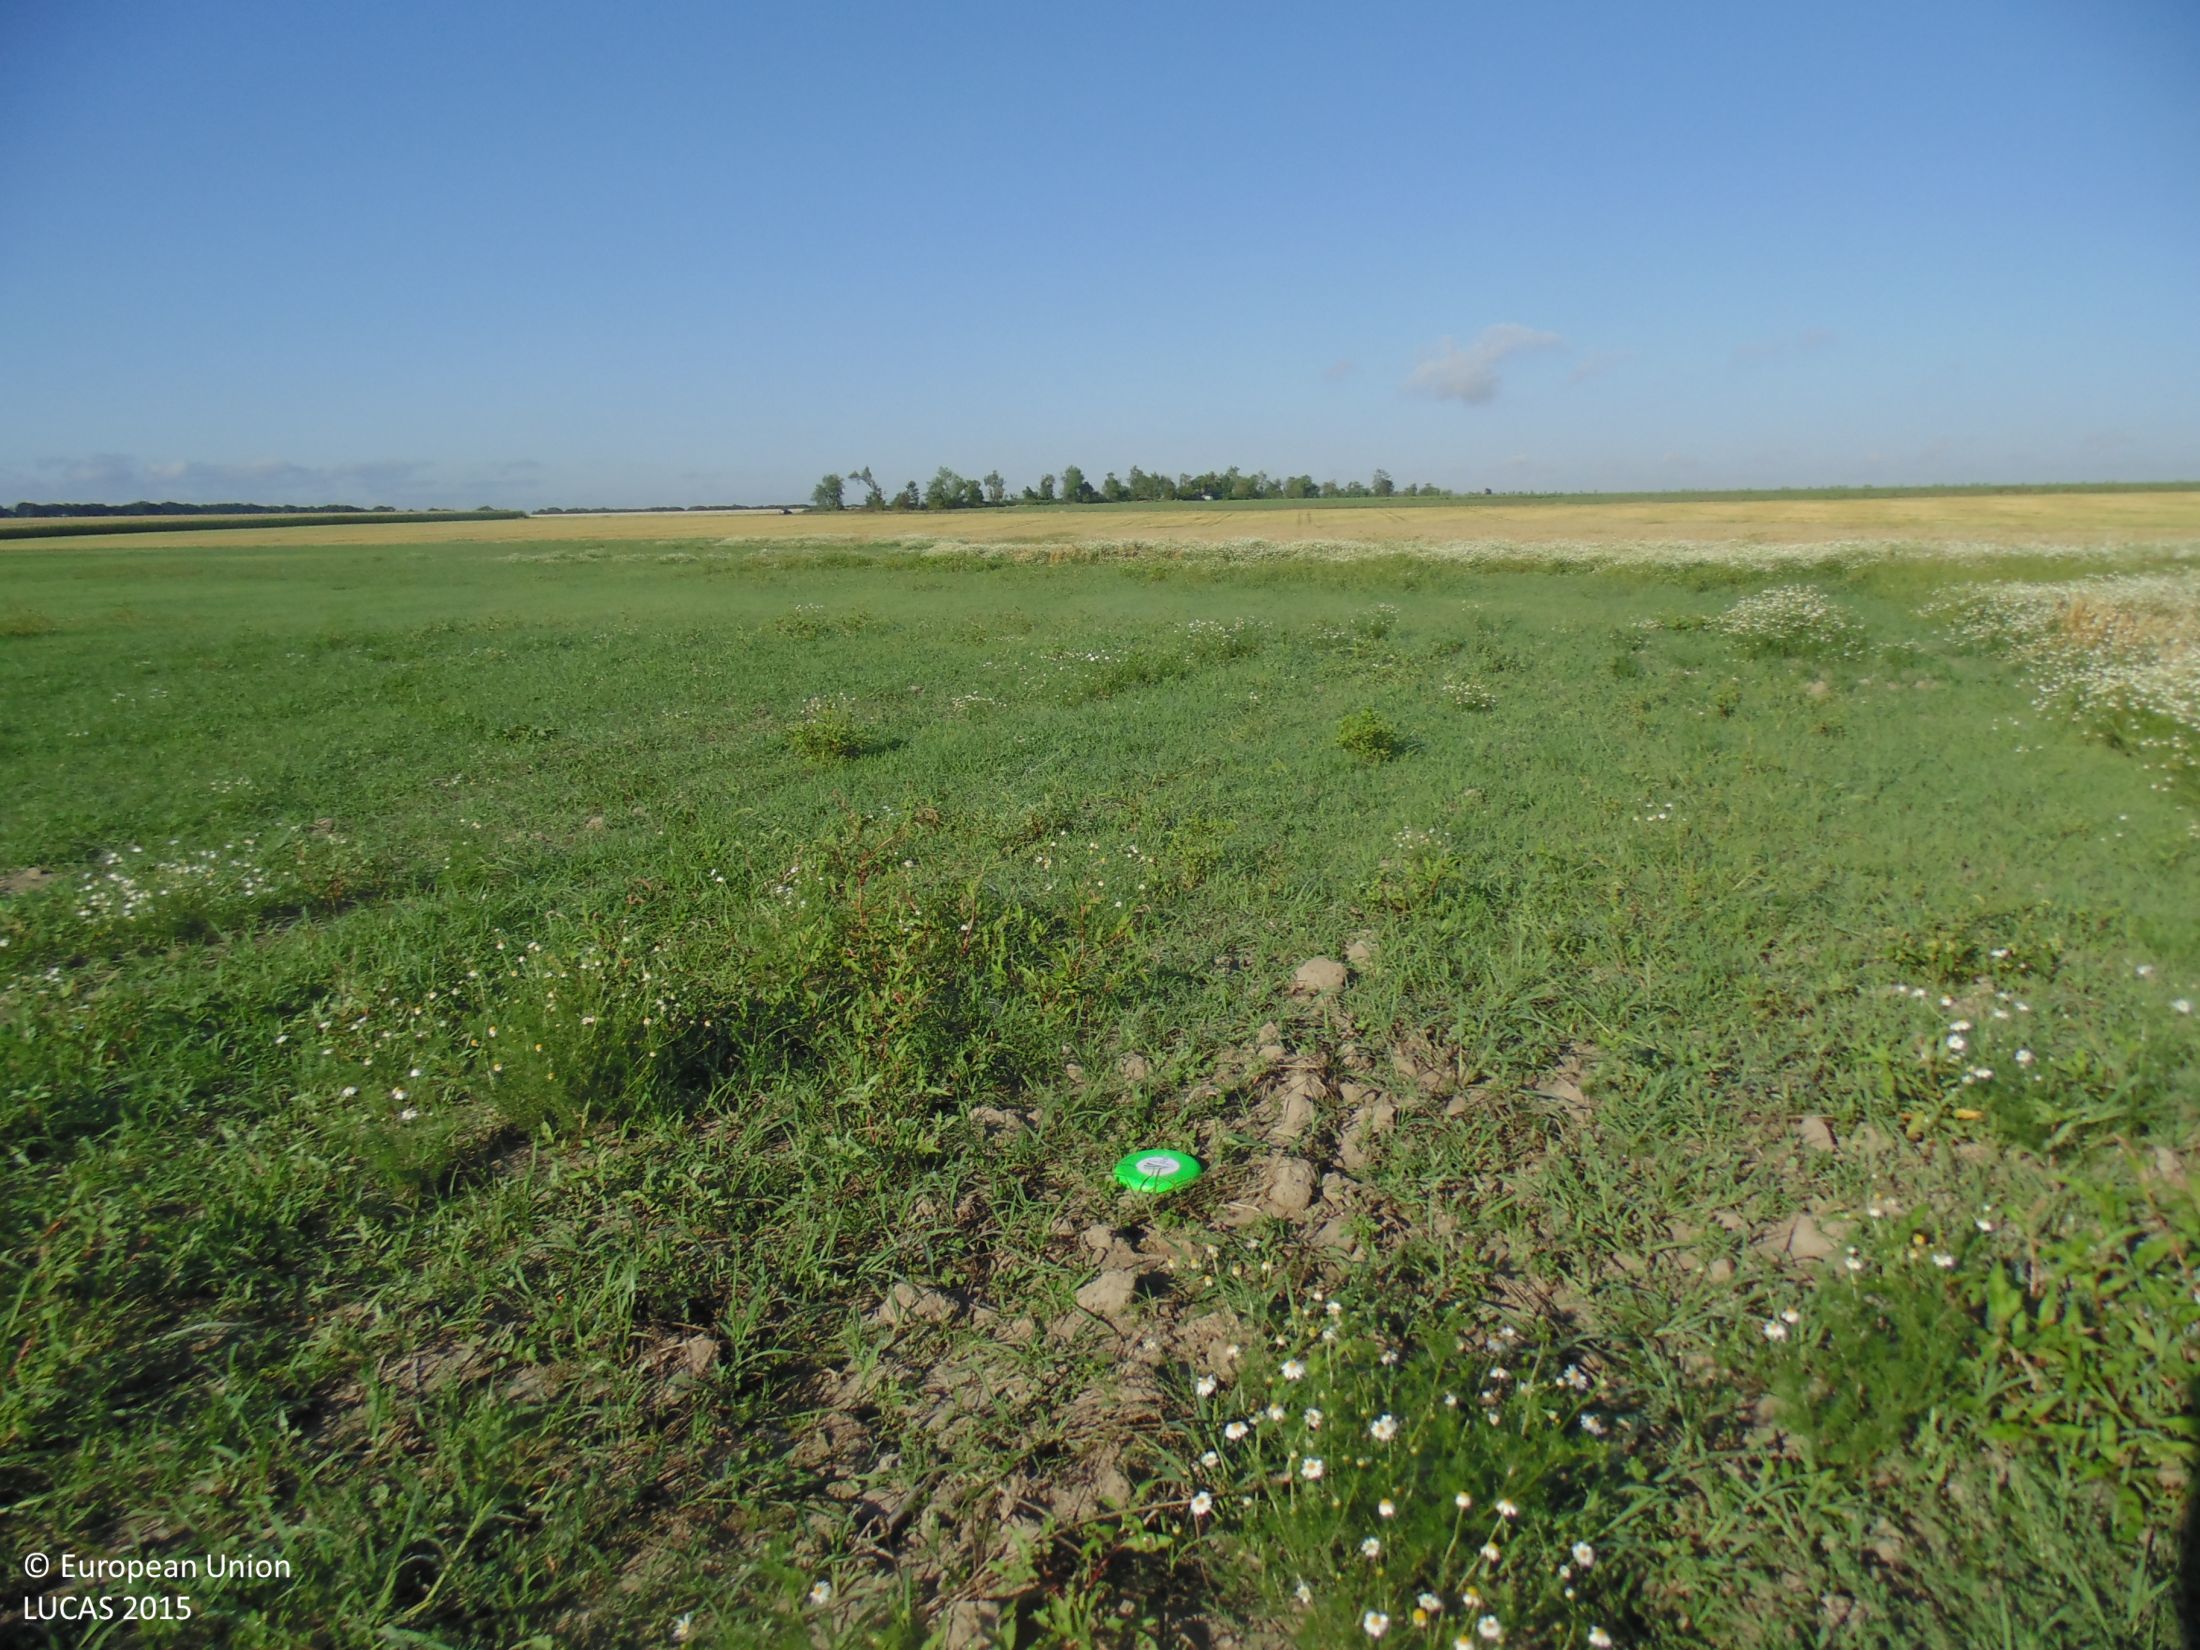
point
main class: Grassland
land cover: Spontaneously vegetated surfaces
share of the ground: > 75 %
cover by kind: herbaceous plants 80 %, unconsolidated bare surface 20 %
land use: Fallow land
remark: Temporary dry
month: July
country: BG
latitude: 43.4867
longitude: 27.9619
